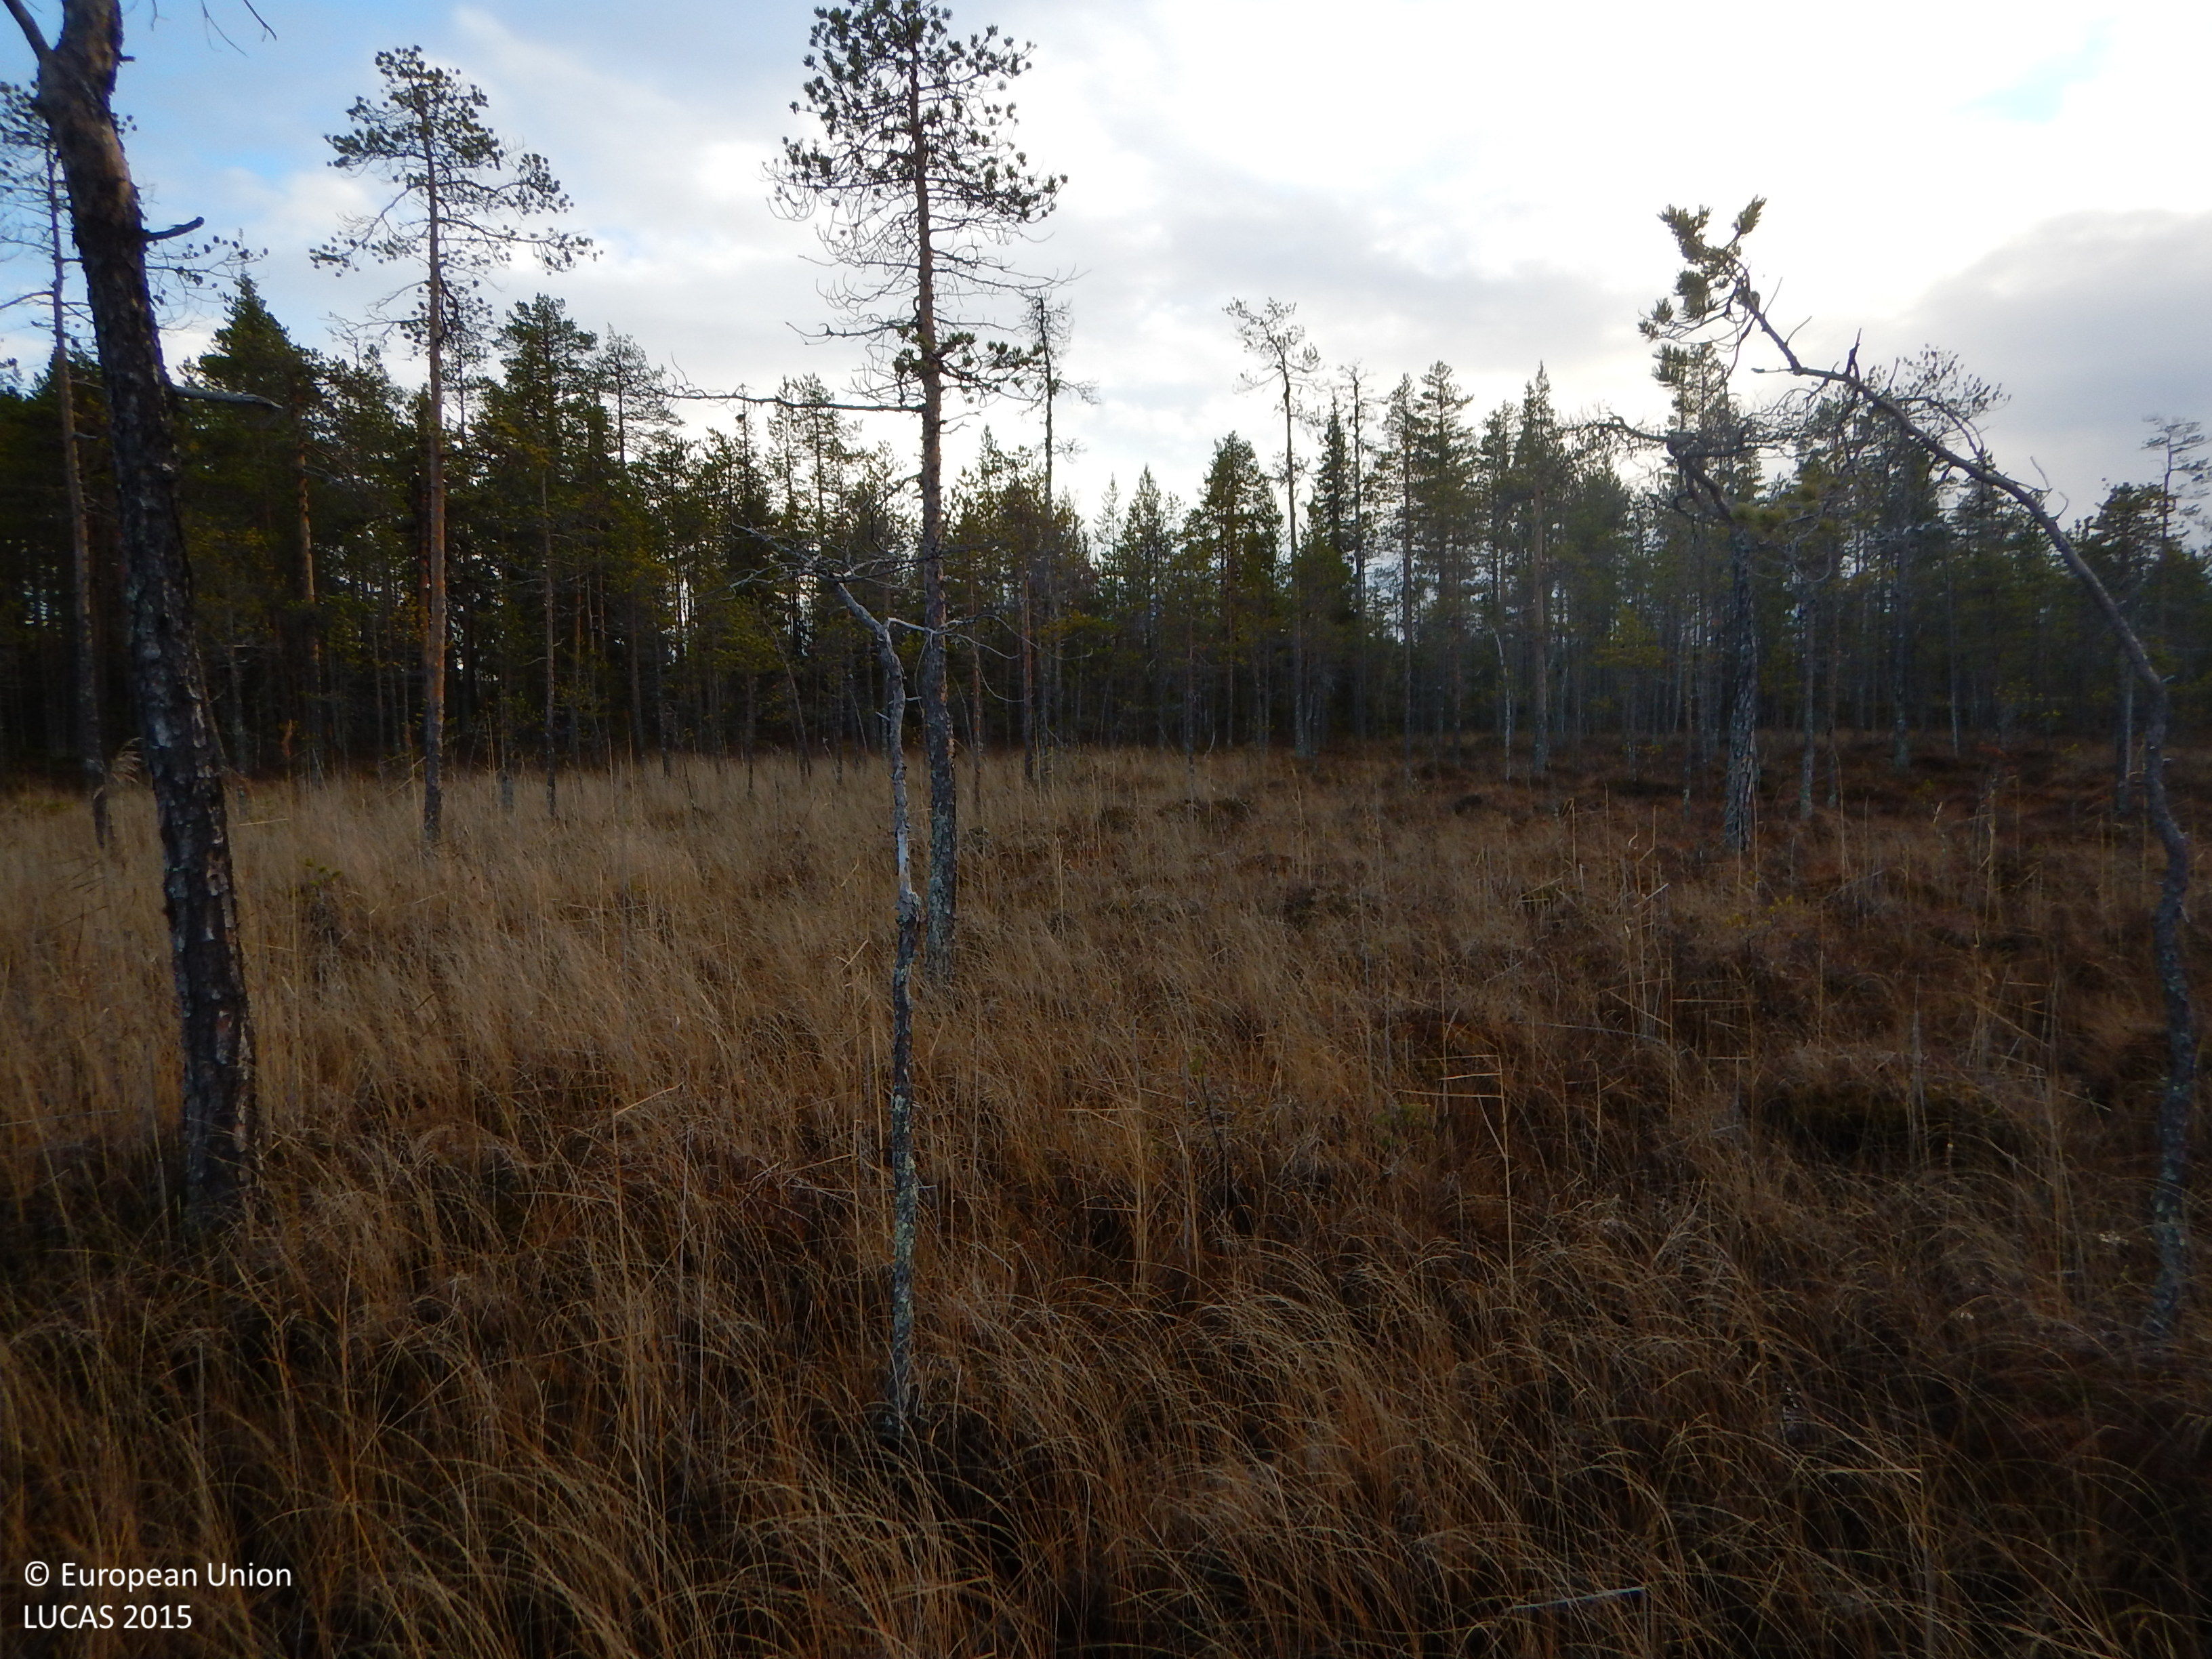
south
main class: Woodland
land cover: Pine dominated coniferous woodland
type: mire and swamp forests
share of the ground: 25 - 50 %
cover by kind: coniferous forest trees 30 %, lichens and mosses 30 %, herbaceous plants 20 %, shrubs 15 %, broadleaved forest trees 5 %
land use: Semi-natural and natural areas not in use
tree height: < 5 m
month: October
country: SE
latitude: 65.3201
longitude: 20.0329
